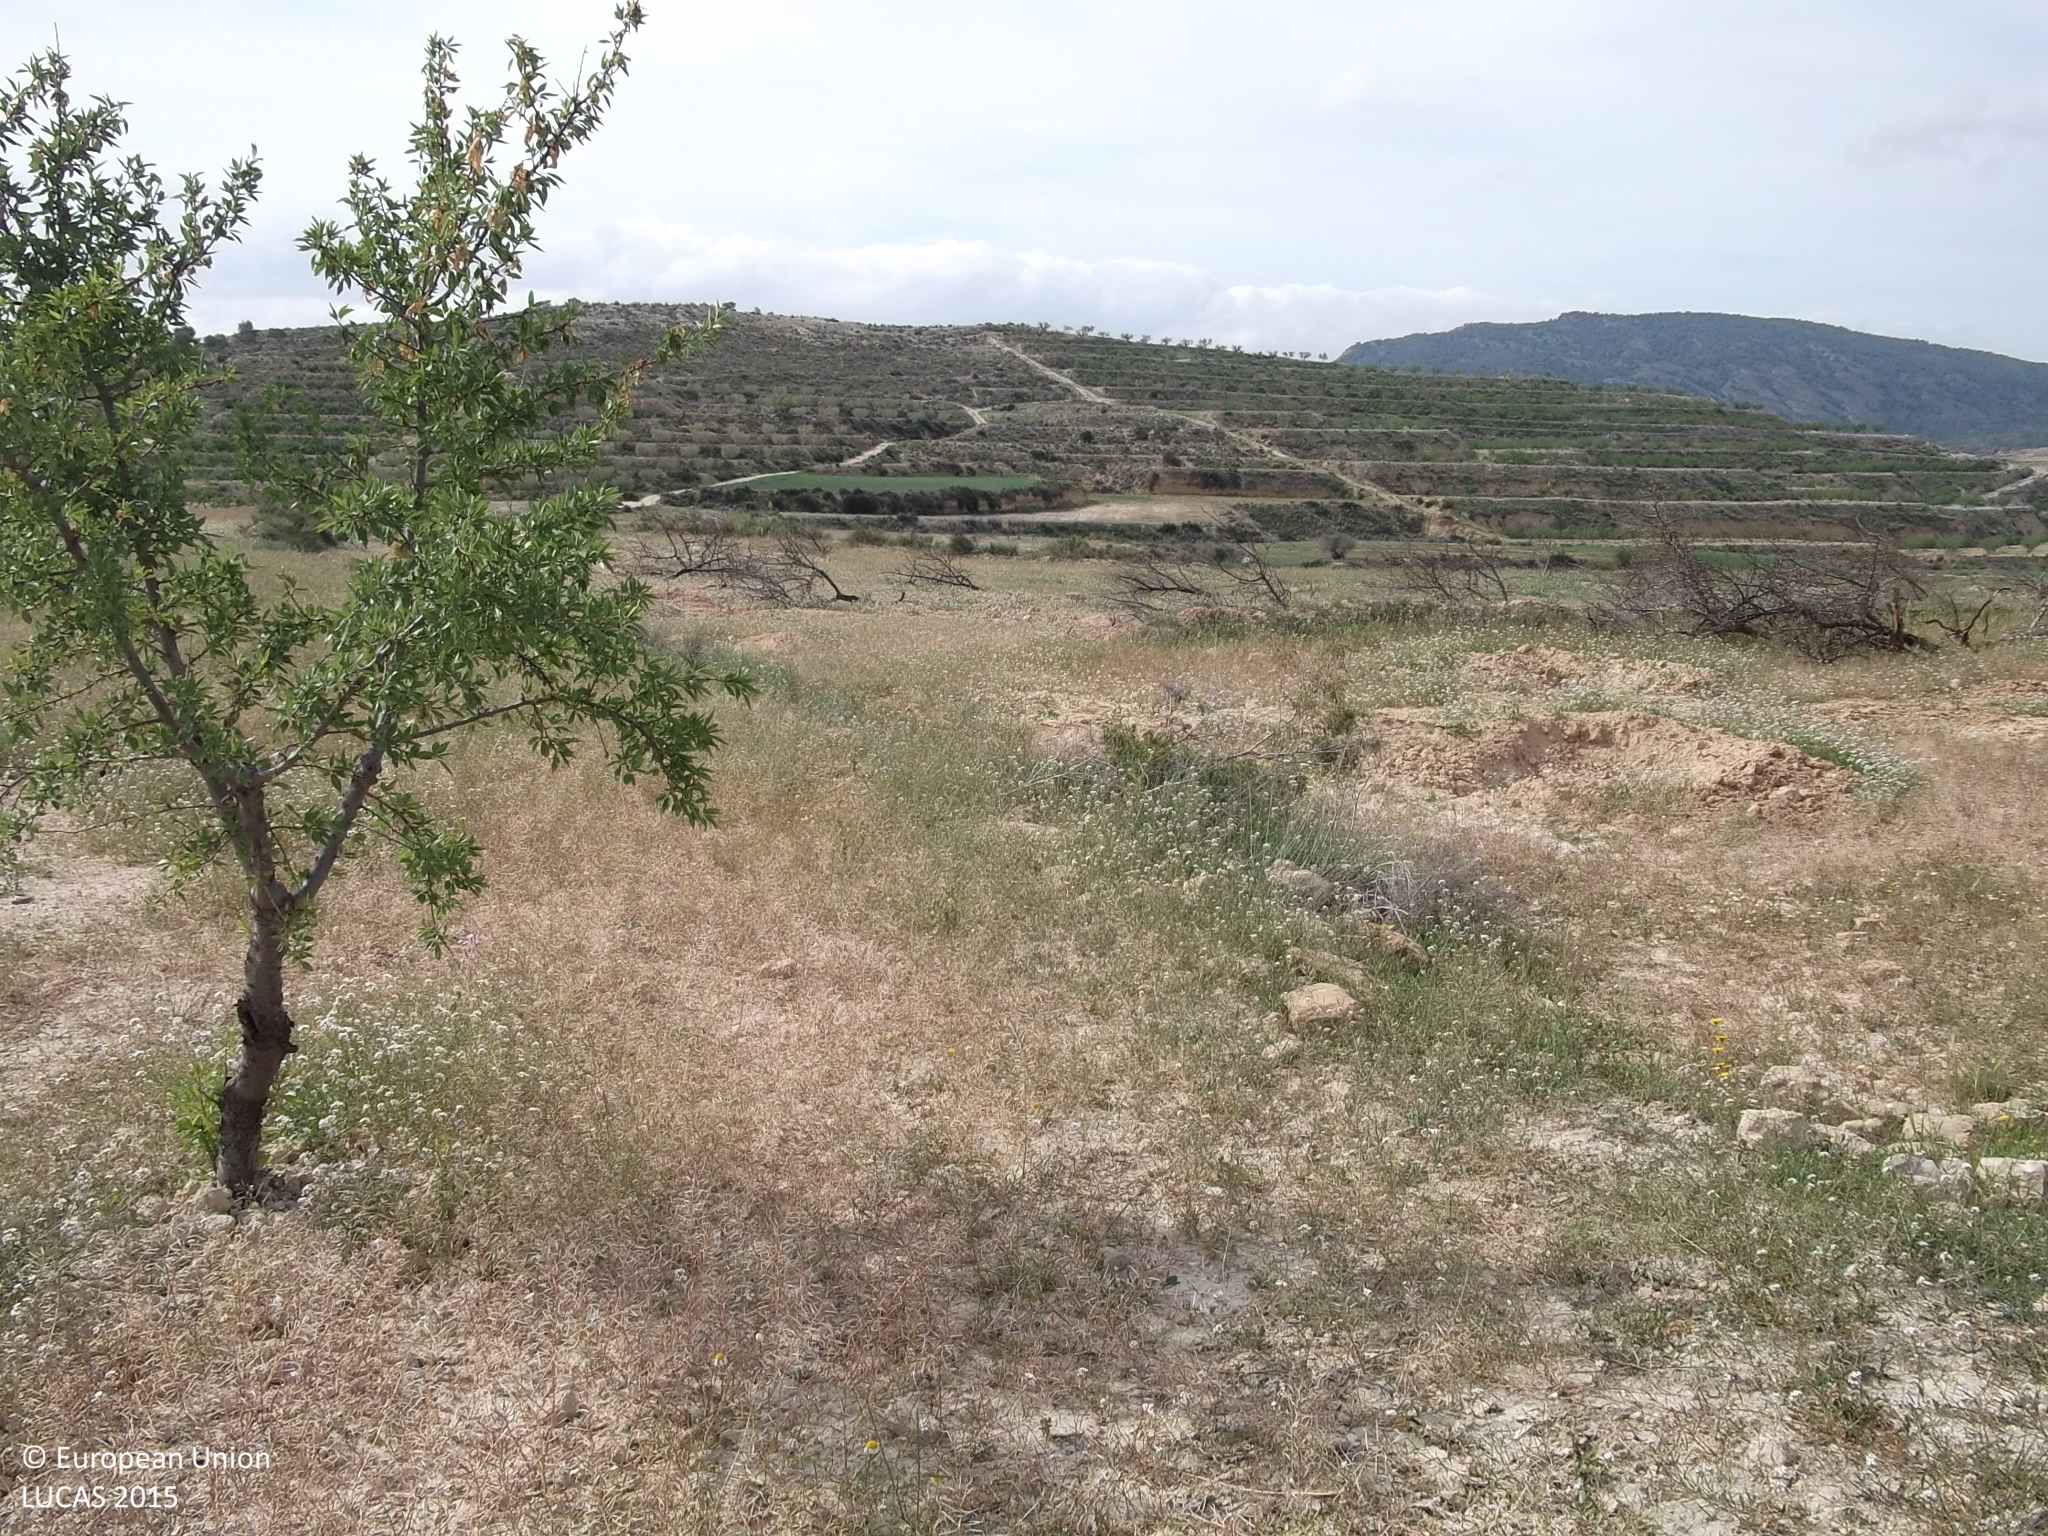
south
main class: Cropland
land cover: Nuts trees
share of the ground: 10 - 25 %
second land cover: Spontaneously vegetated surfaces
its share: > 75 %
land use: Agriculture (excluding fallow land and kitchen gardens)
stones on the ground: < 10 %
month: April
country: ES
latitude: 37.9202
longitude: -1.3940
